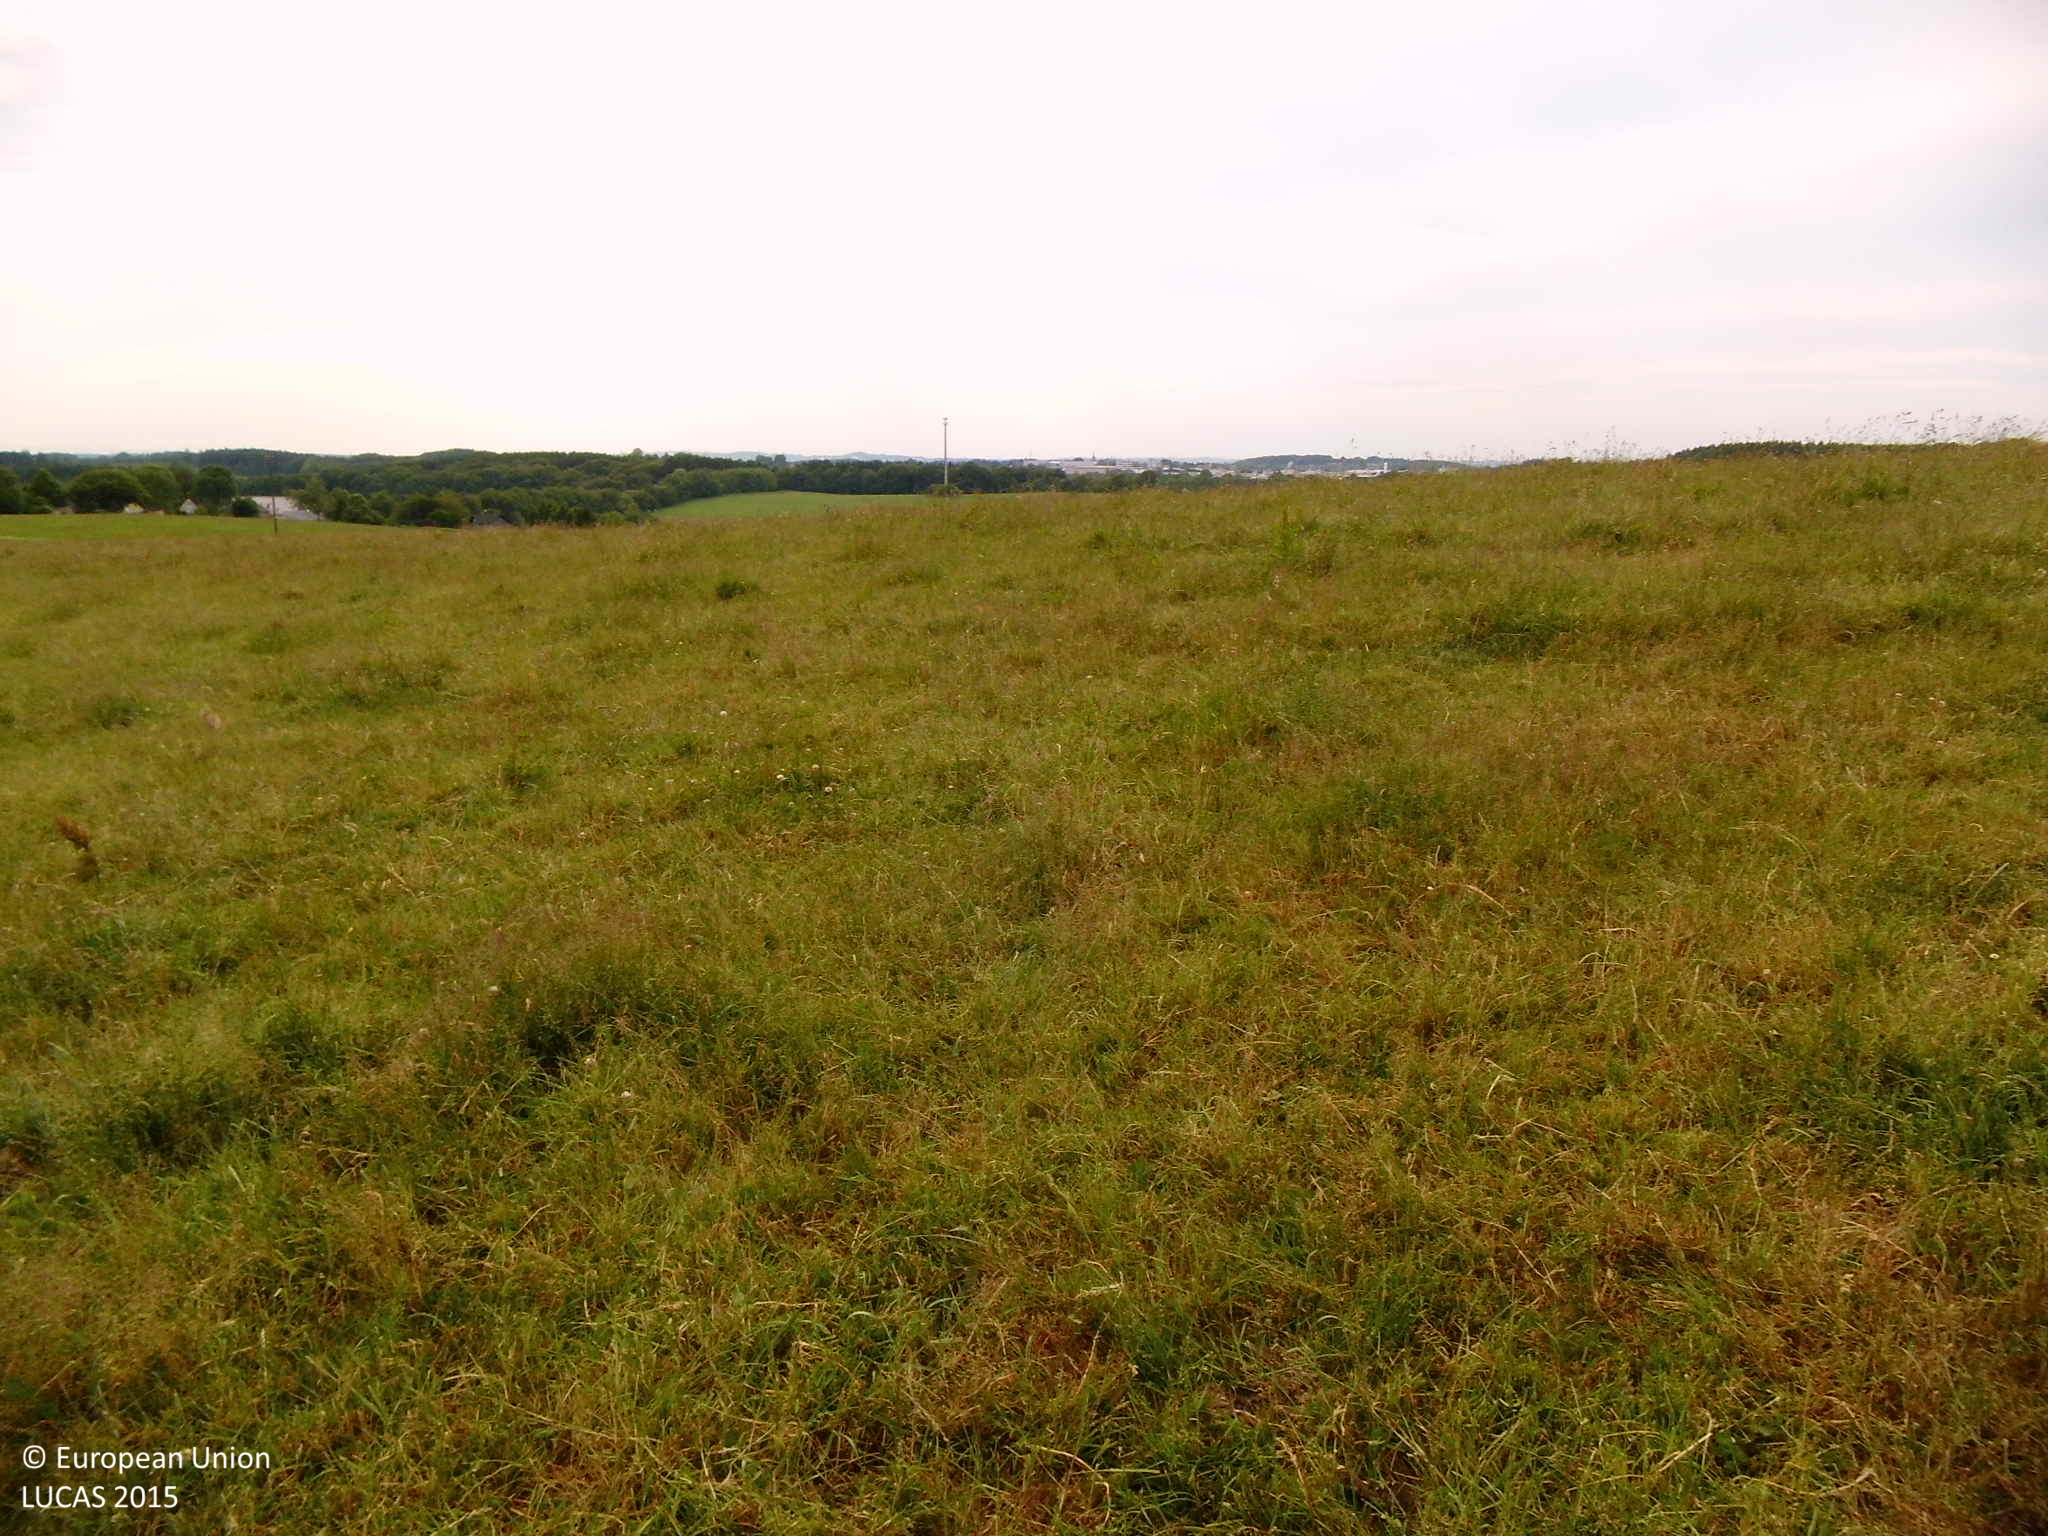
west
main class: Grassland
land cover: Grassland without tree/shrub cover
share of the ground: > 75 %
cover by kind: herbaceous plants 100 %
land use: Agriculture (excluding fallow land and kitchen gardens)
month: June
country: DE
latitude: 51.1982
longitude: 7.4099
